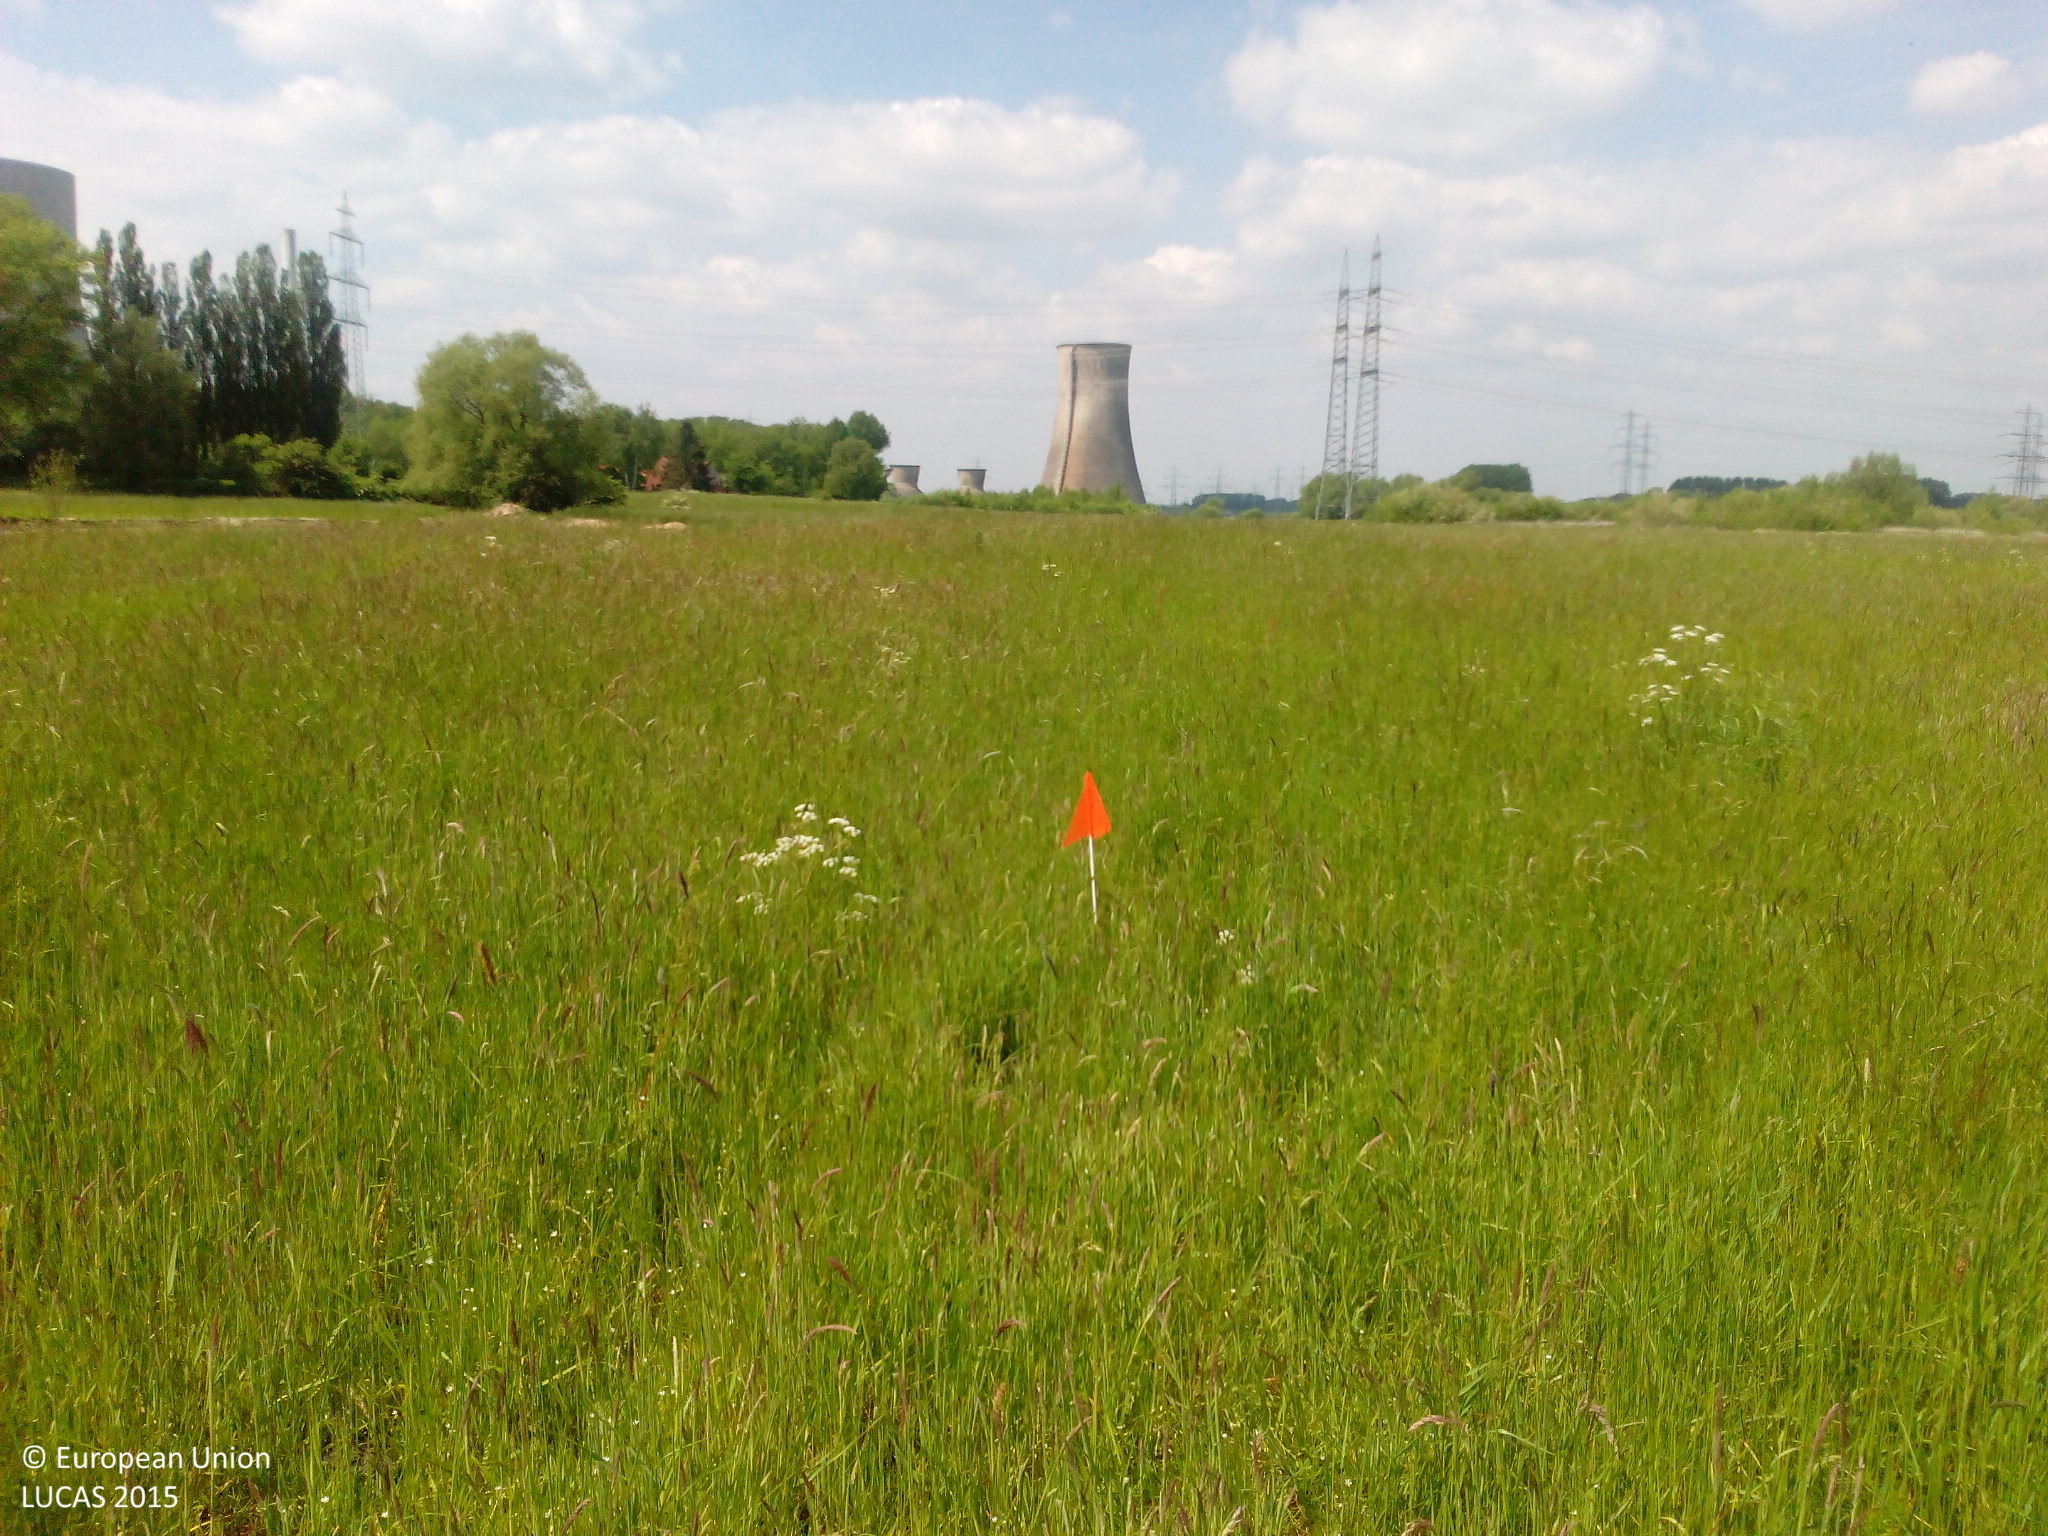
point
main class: Grassland
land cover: Grassland without tree/shrub cover
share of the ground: > 75 %
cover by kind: herbaceous plants 100 %
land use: Agriculture (excluding fallow land and kitchen gardens)
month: May
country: DE
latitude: 51.6772
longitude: 7.9902
